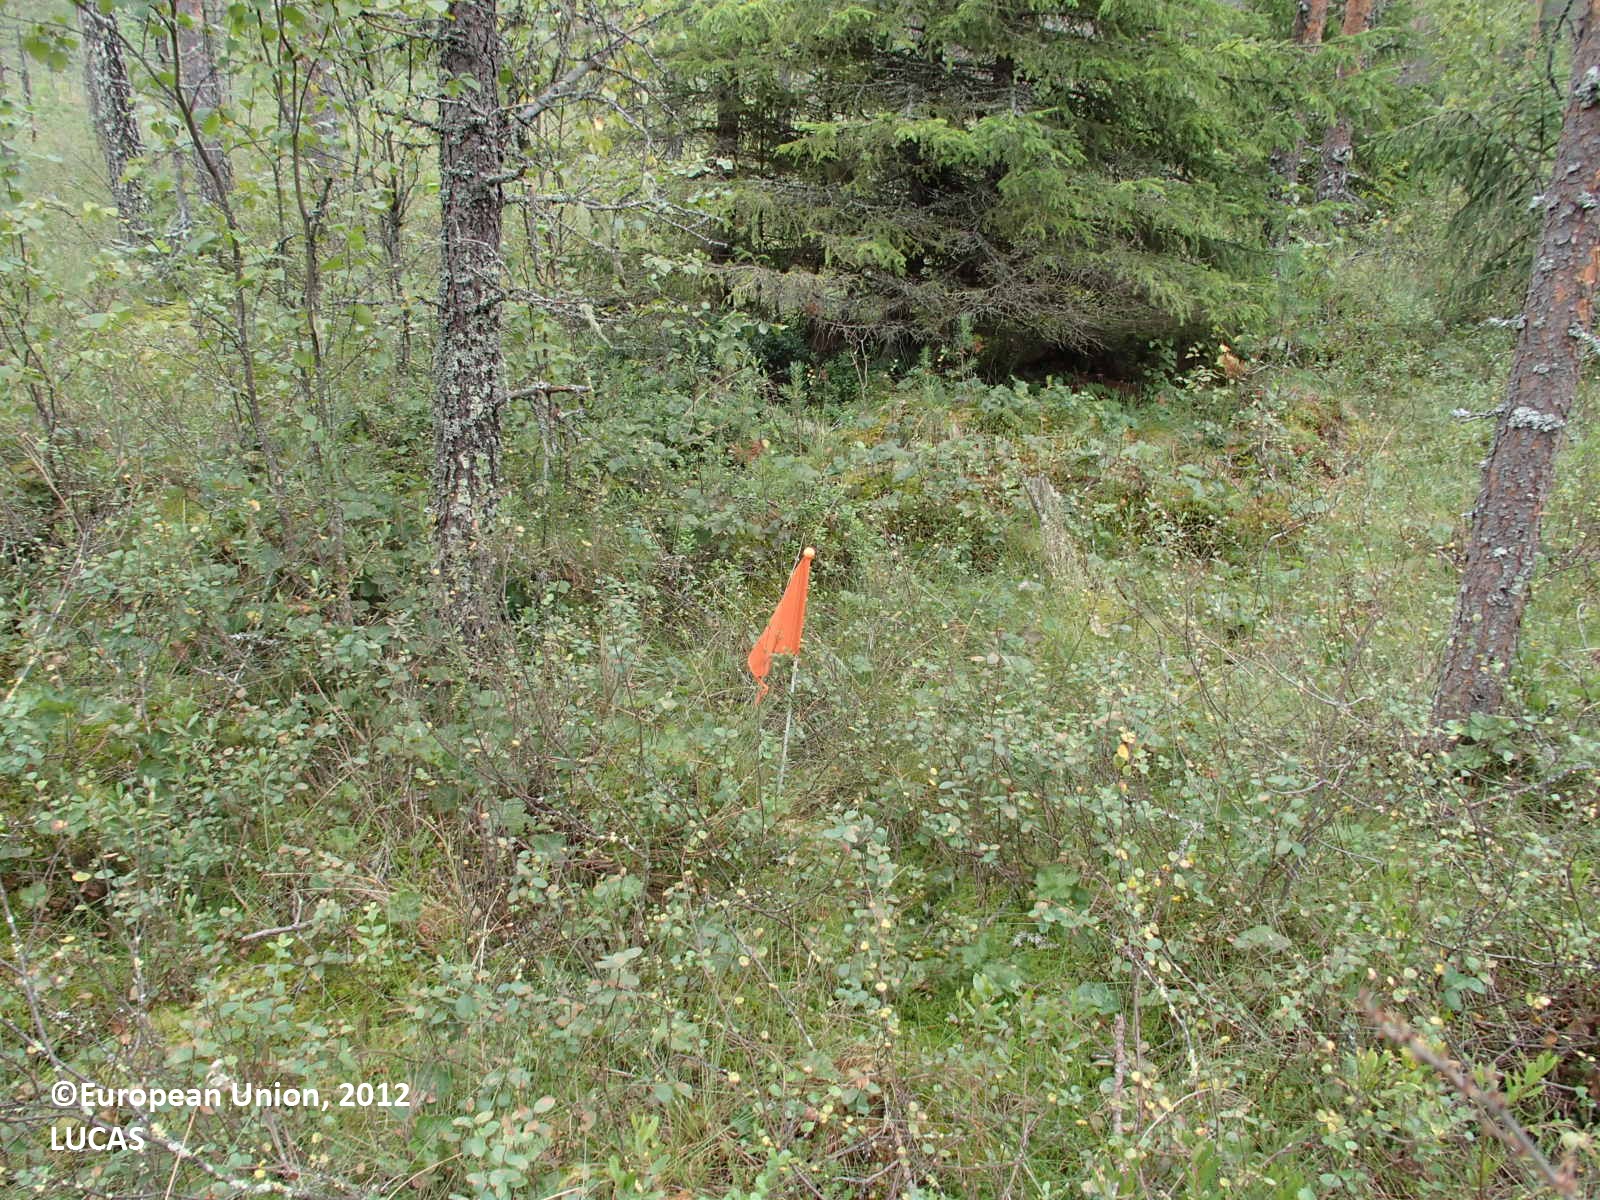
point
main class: Woodland
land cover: Other coniferous woodland
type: boreal forest
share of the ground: > 75 %
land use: Forestry
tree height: > 5 m
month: August
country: FI
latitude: 63.6314
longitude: 27.8642
